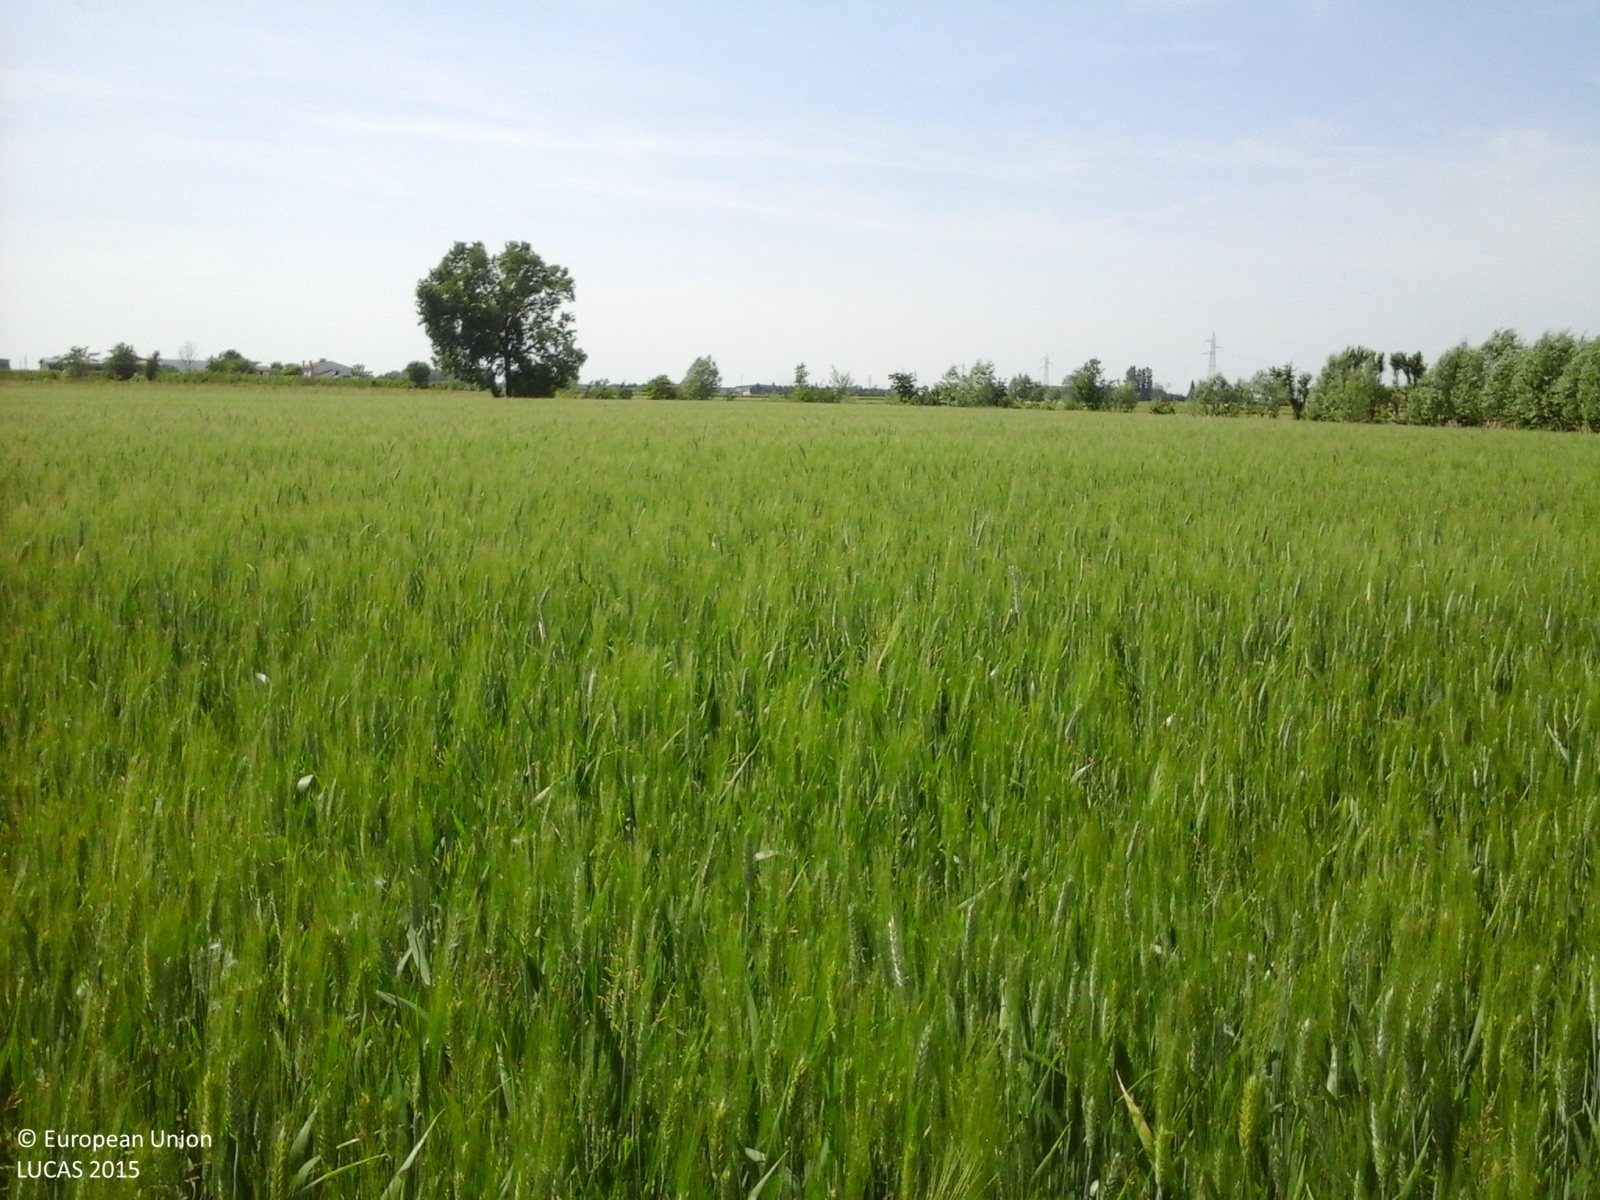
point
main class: Cropland
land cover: Common wheat
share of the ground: > 75 %
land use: Agriculture (excluding fallow land and kitchen gardens)
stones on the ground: < 10 %
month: May
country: IT
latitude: 44.9441
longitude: 10.5692
